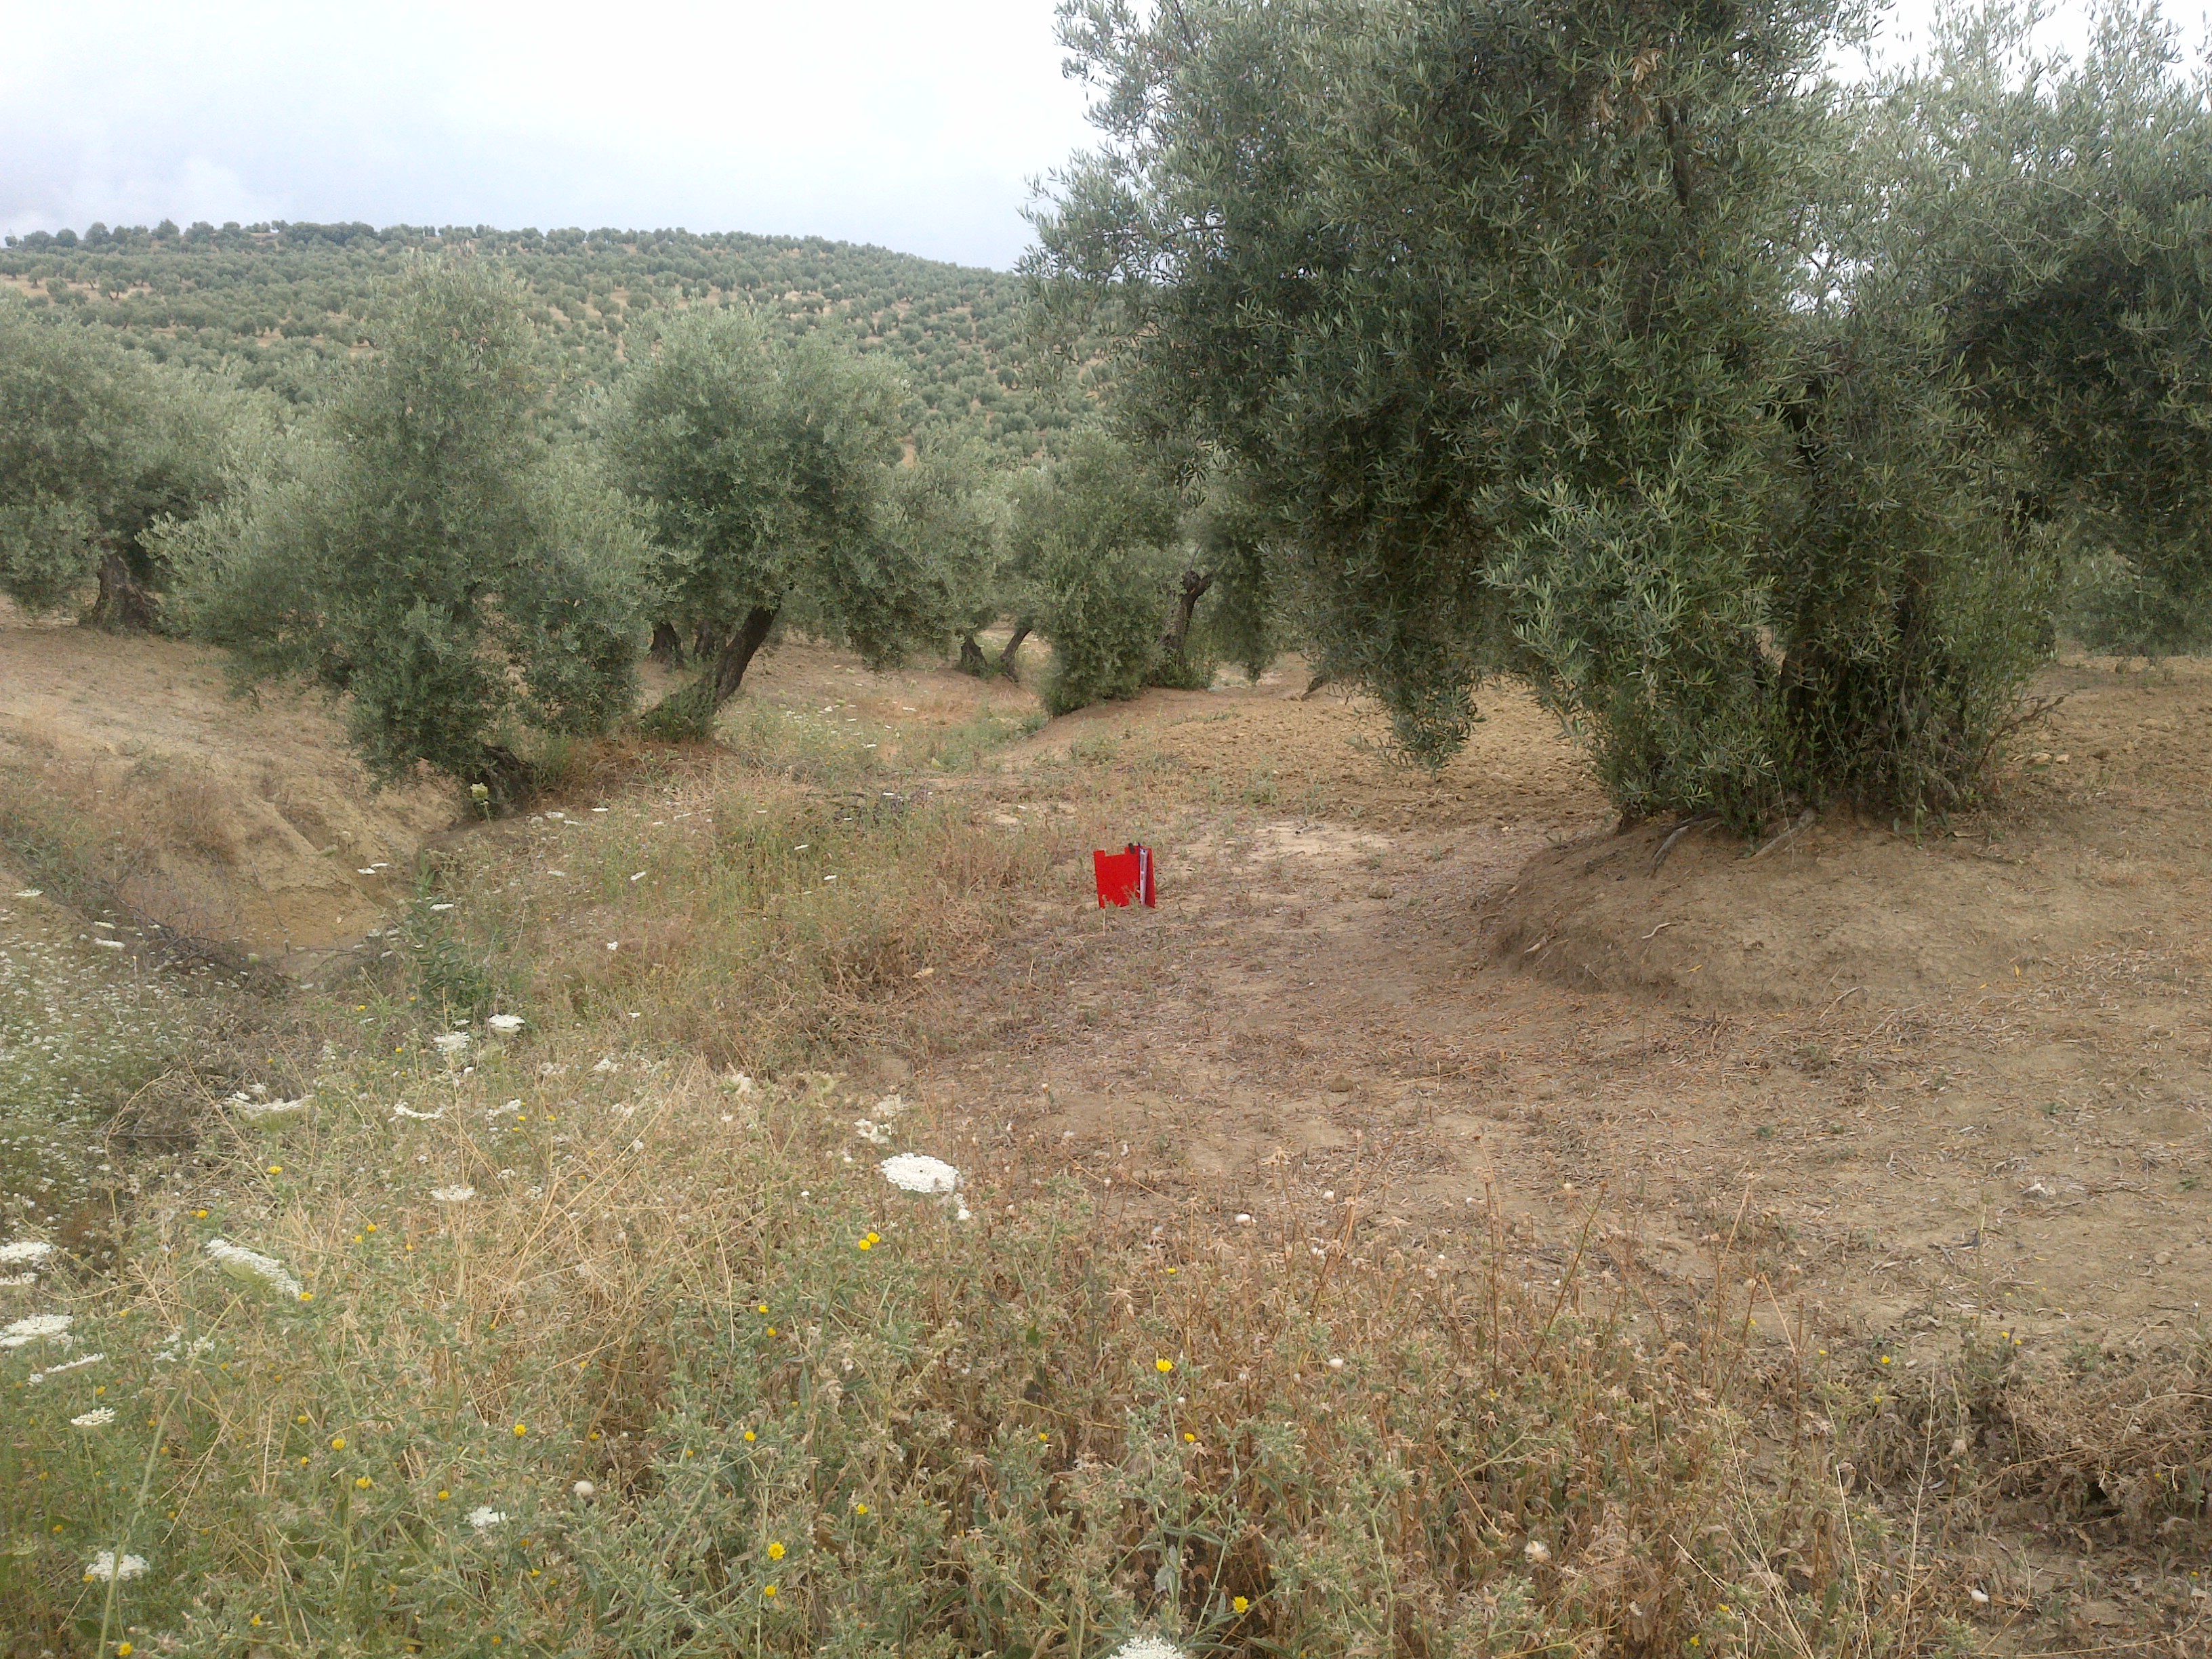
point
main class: Cropland
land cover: Olive groves
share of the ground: 25 - 50 %
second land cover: Other bare soil
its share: > 75 %
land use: Agriculture (excluding fallow land and kitchen gardens)
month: June
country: ES
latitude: 37.9240
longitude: -4.3319
